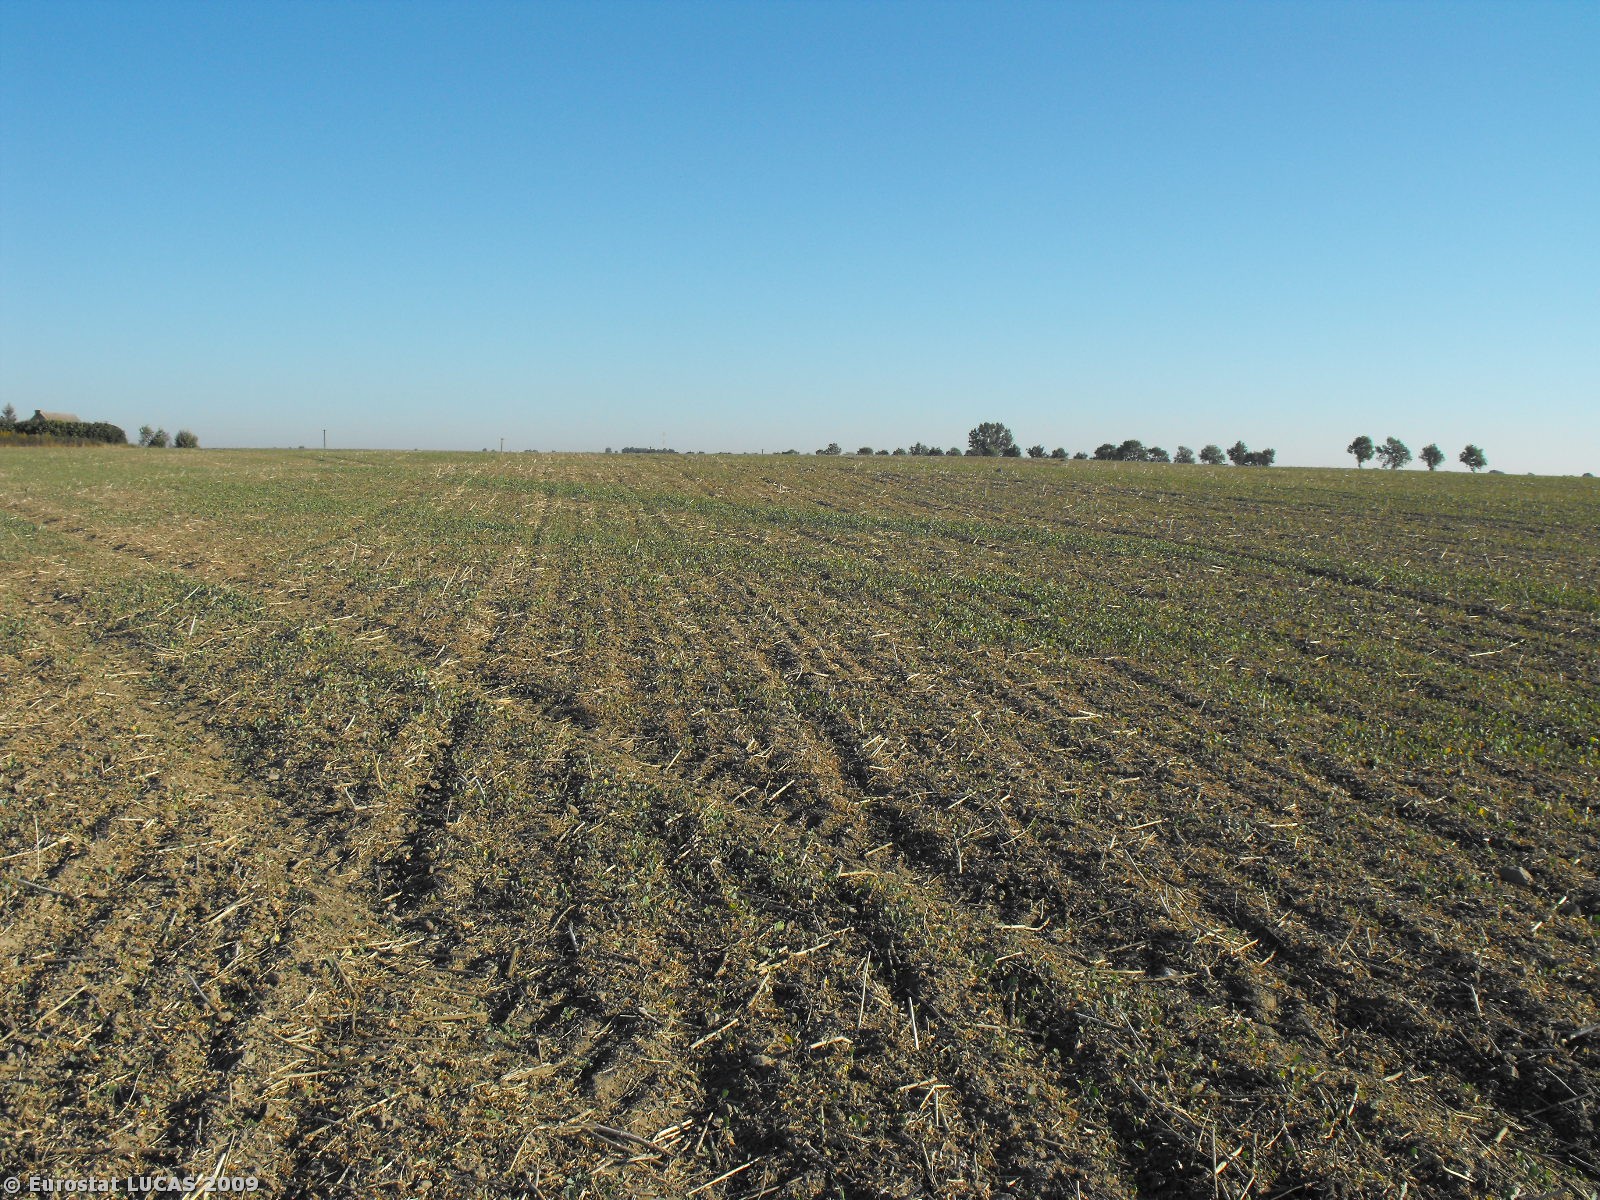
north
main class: Cropland
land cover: Rape and turnip rape
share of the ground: < 10 %
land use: Agriculture (excluding fallow land and kitchen gardens)
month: September
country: PL
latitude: 53.1577
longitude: 16.4526
